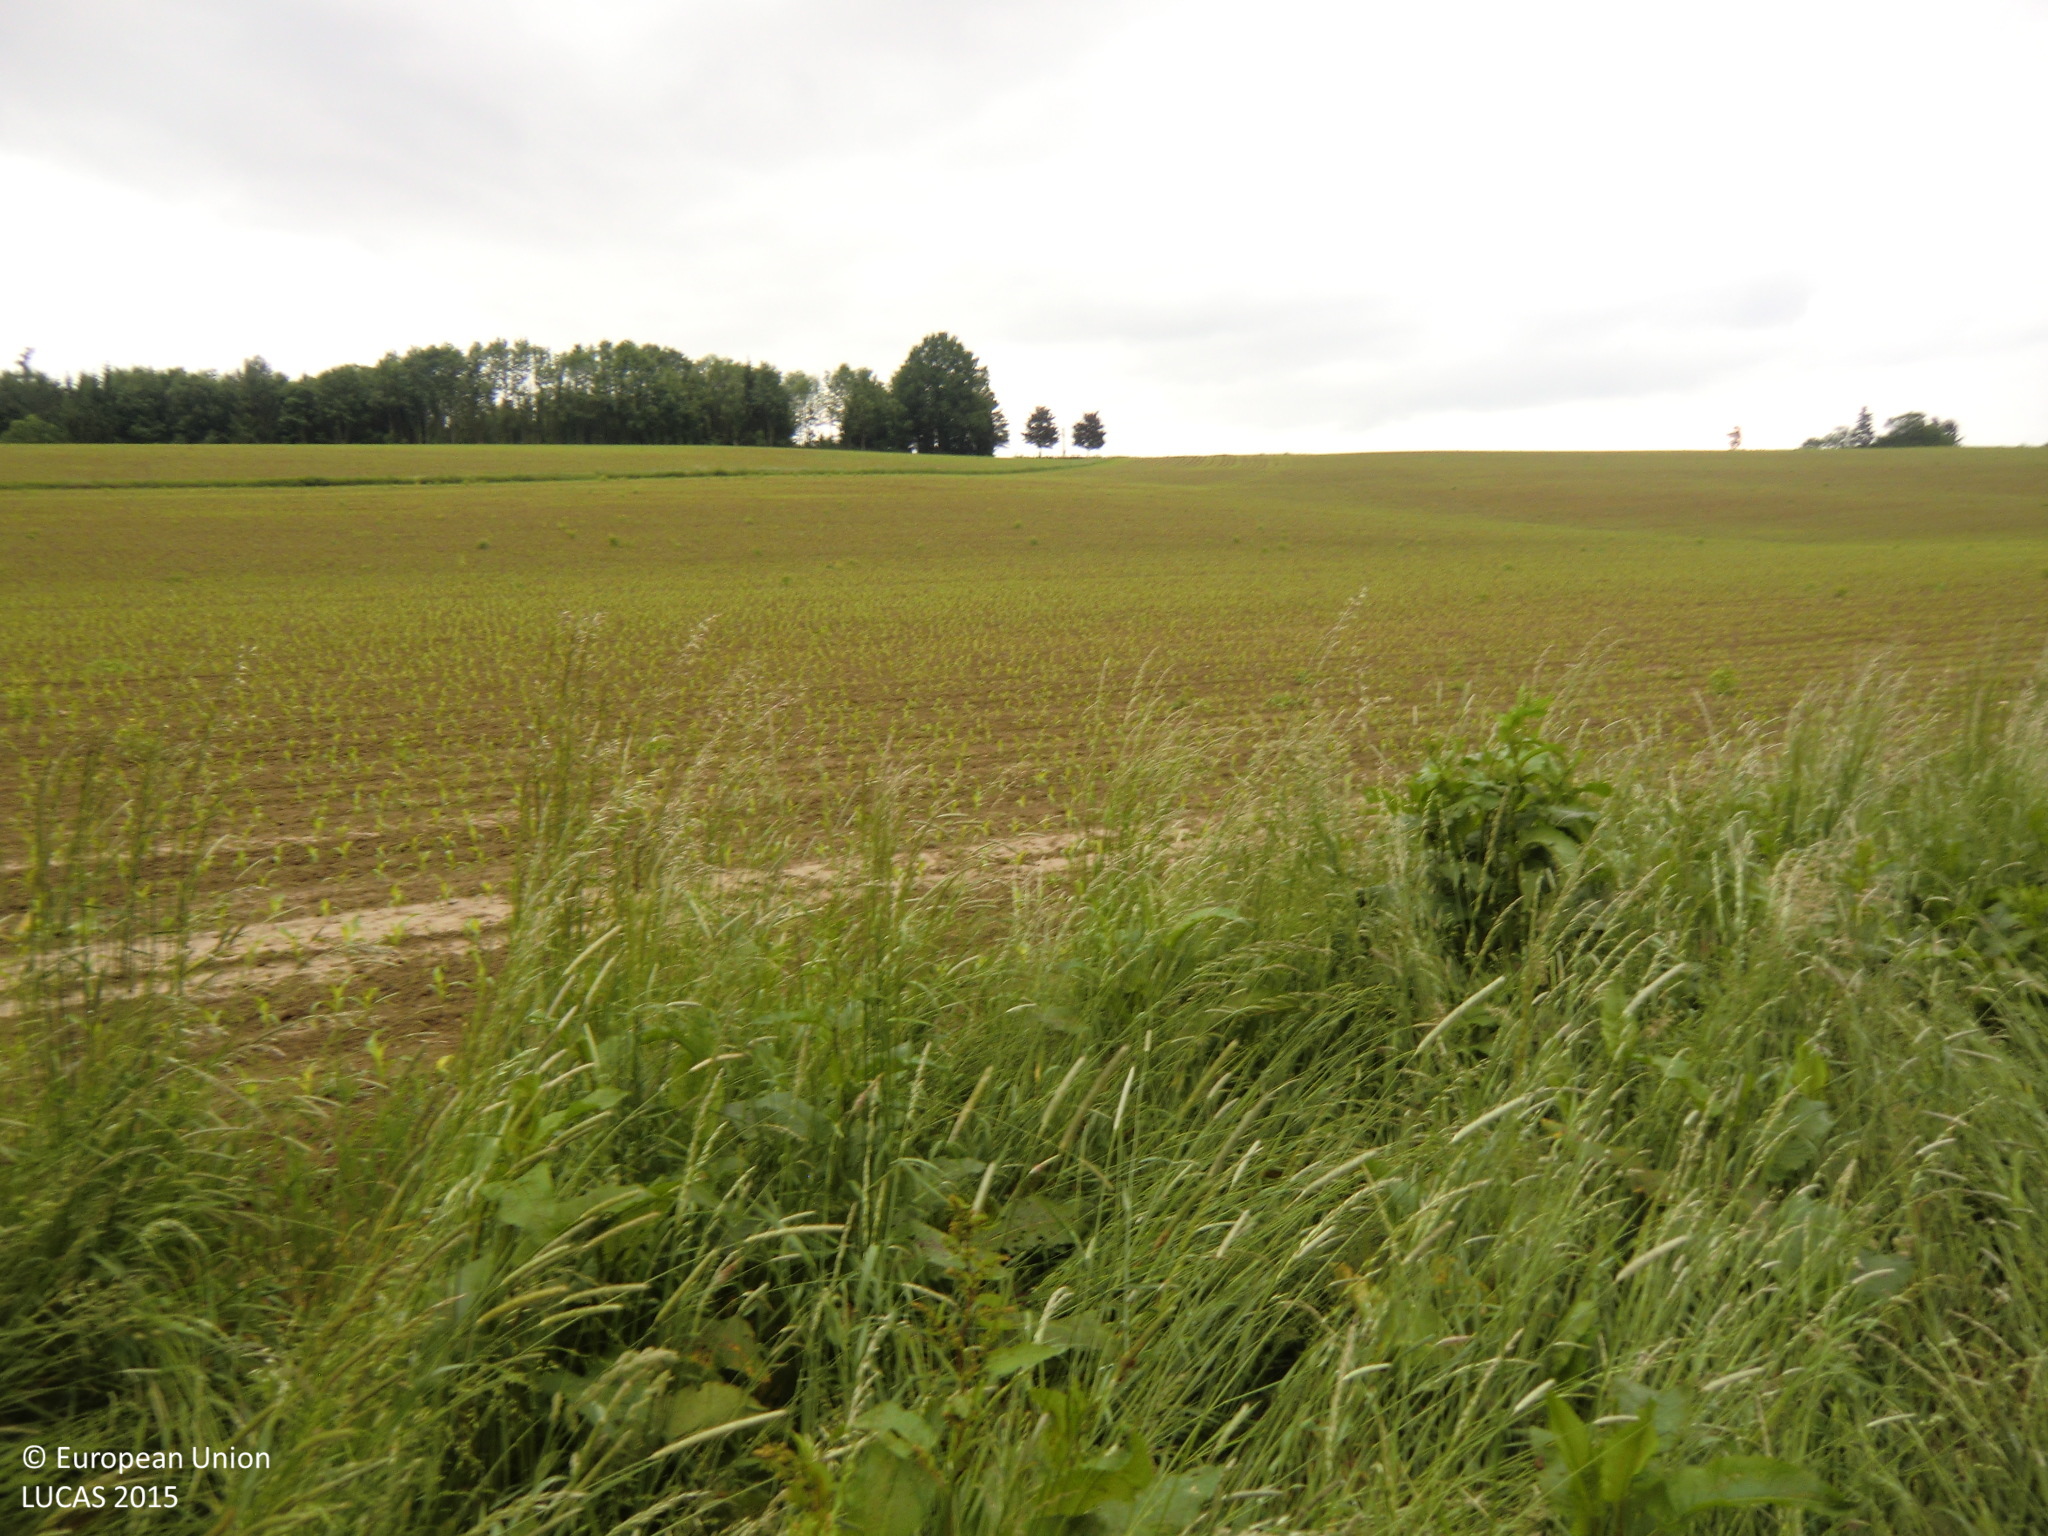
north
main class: Grassland
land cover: Grassland without tree/shrub cover
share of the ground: > 75 %
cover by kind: herbaceous plants 100 %
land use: Agriculture (excluding fallow land and kitchen gardens)
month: May
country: AT
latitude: 48.1291
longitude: 15.3628
